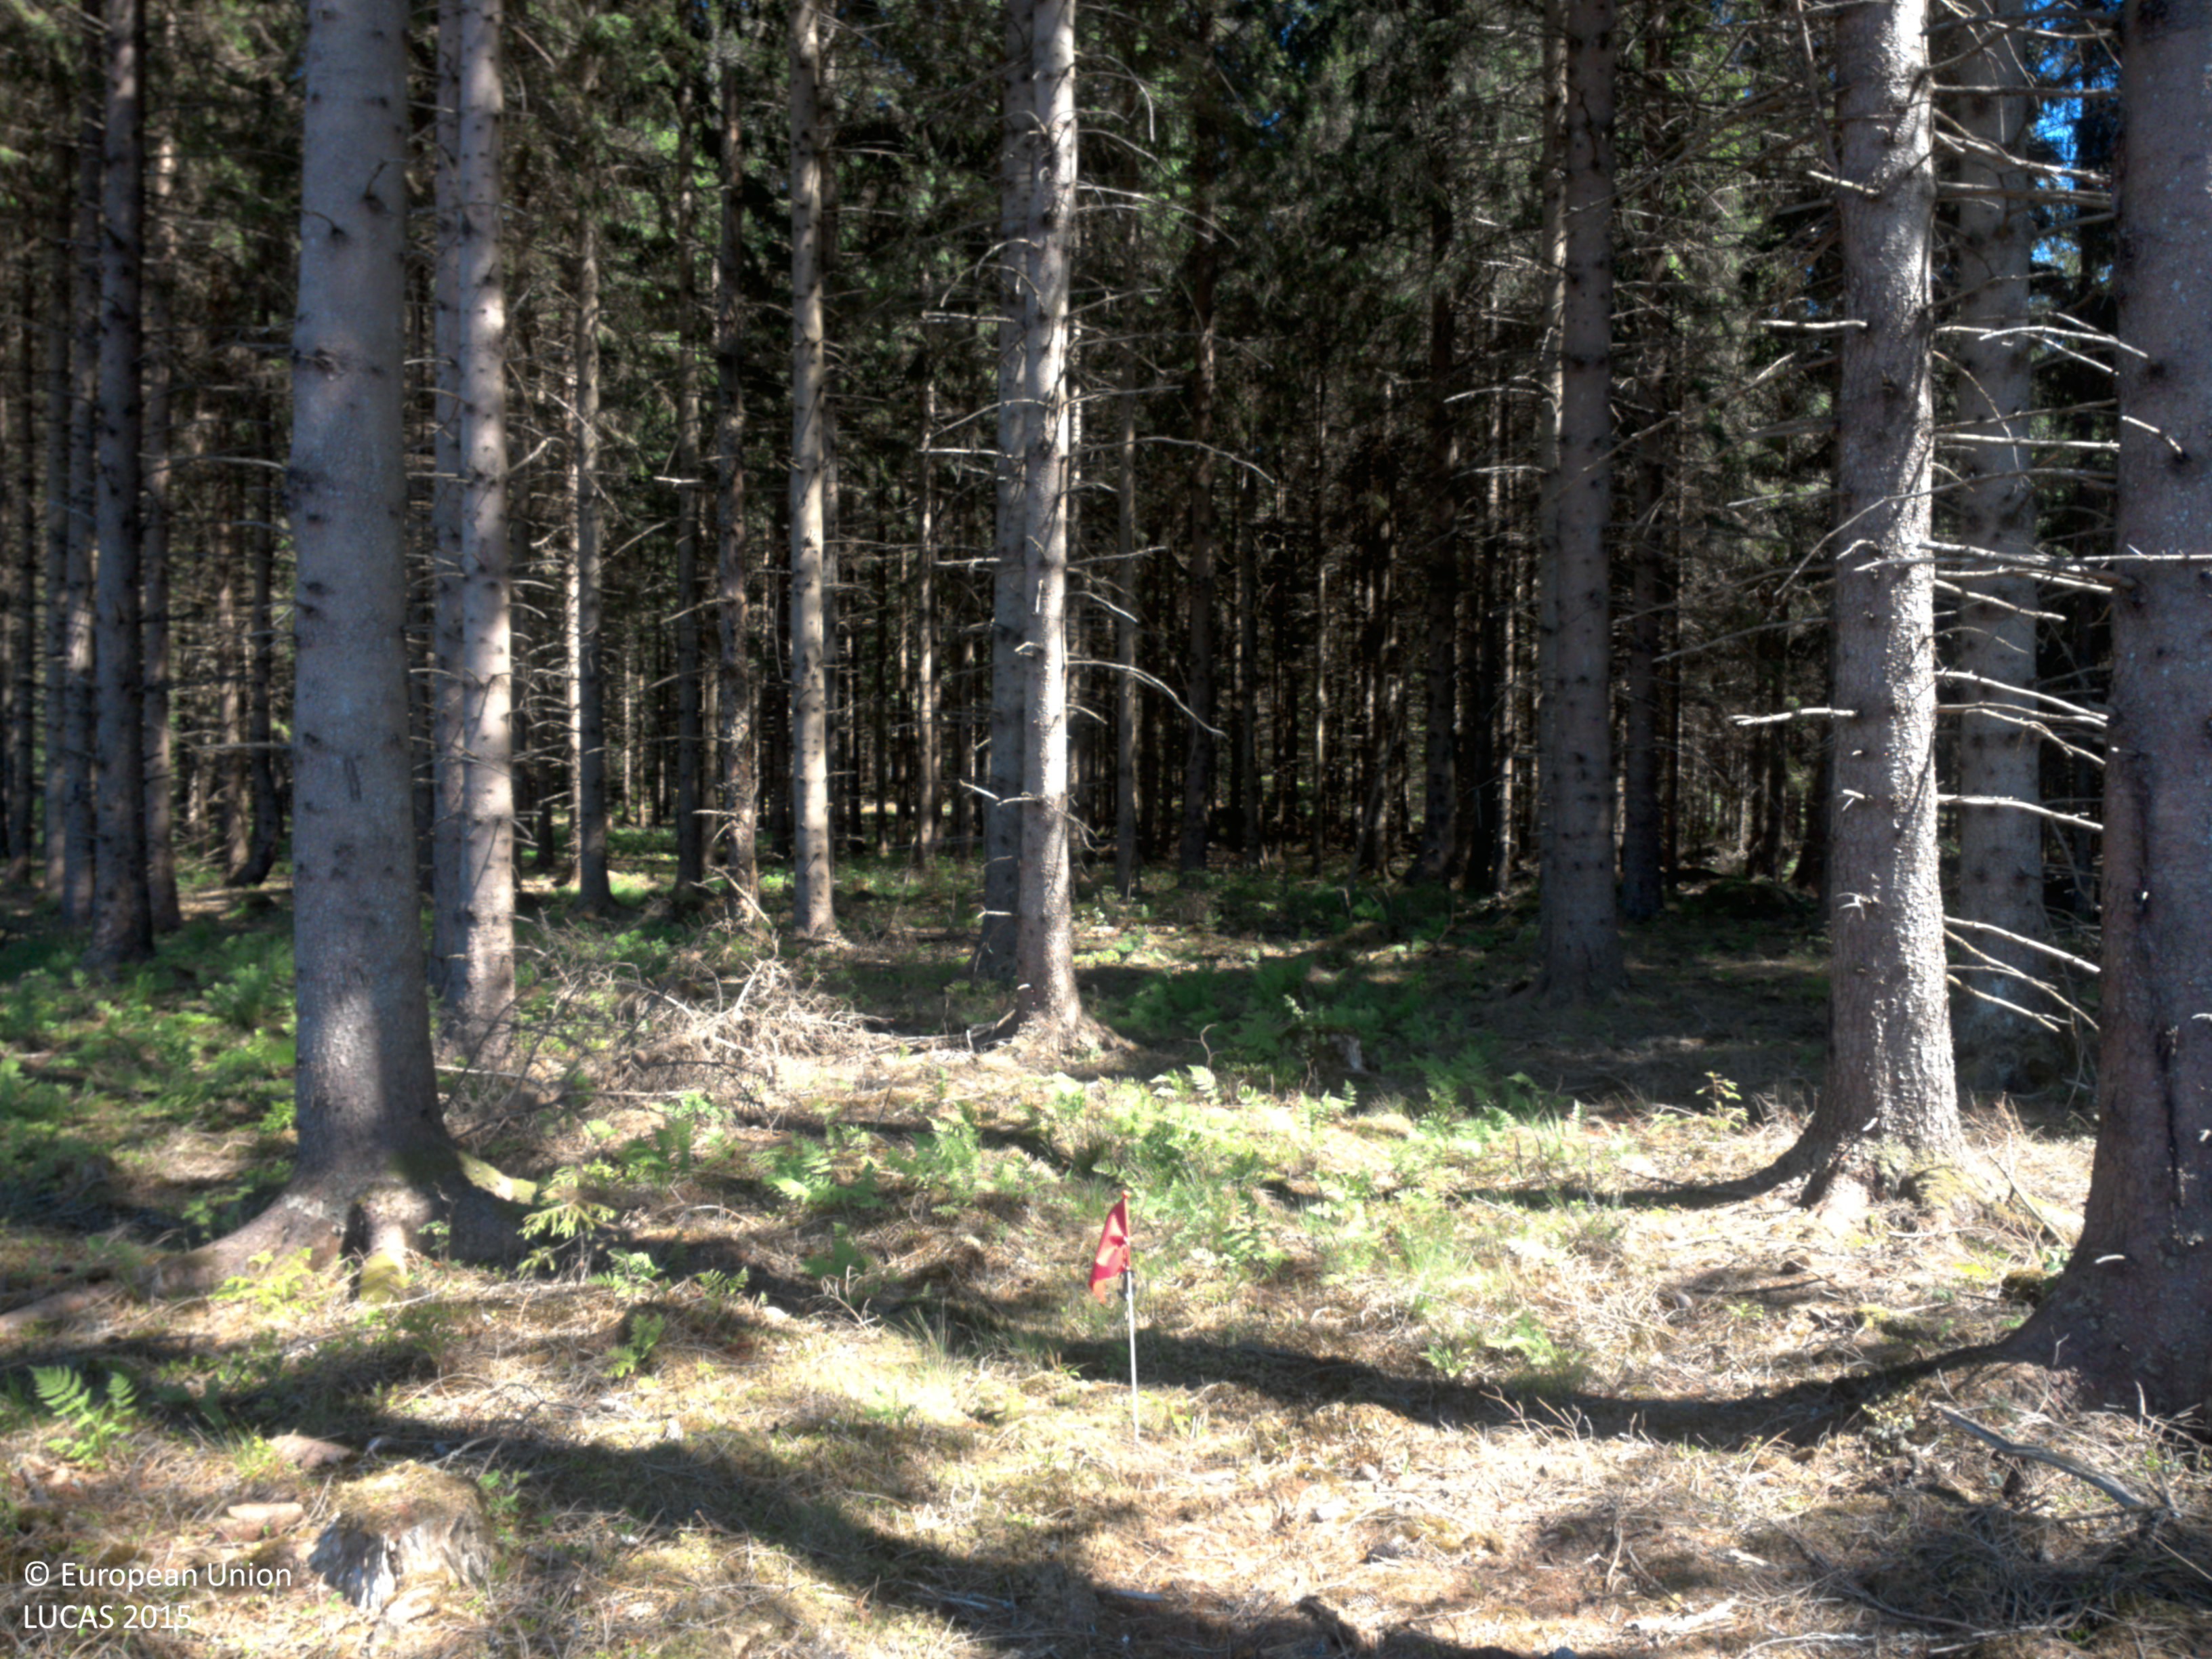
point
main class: Woodland
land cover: Spruce dominated coniferous woodland
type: boreal forest
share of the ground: 50 - 75 %
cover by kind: coniferous forest trees 50 %, lichens and mosses 50 %
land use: Forestry
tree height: > 5 m
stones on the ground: < 10 %
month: July
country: SE
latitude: 58.4755
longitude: 11.9336
